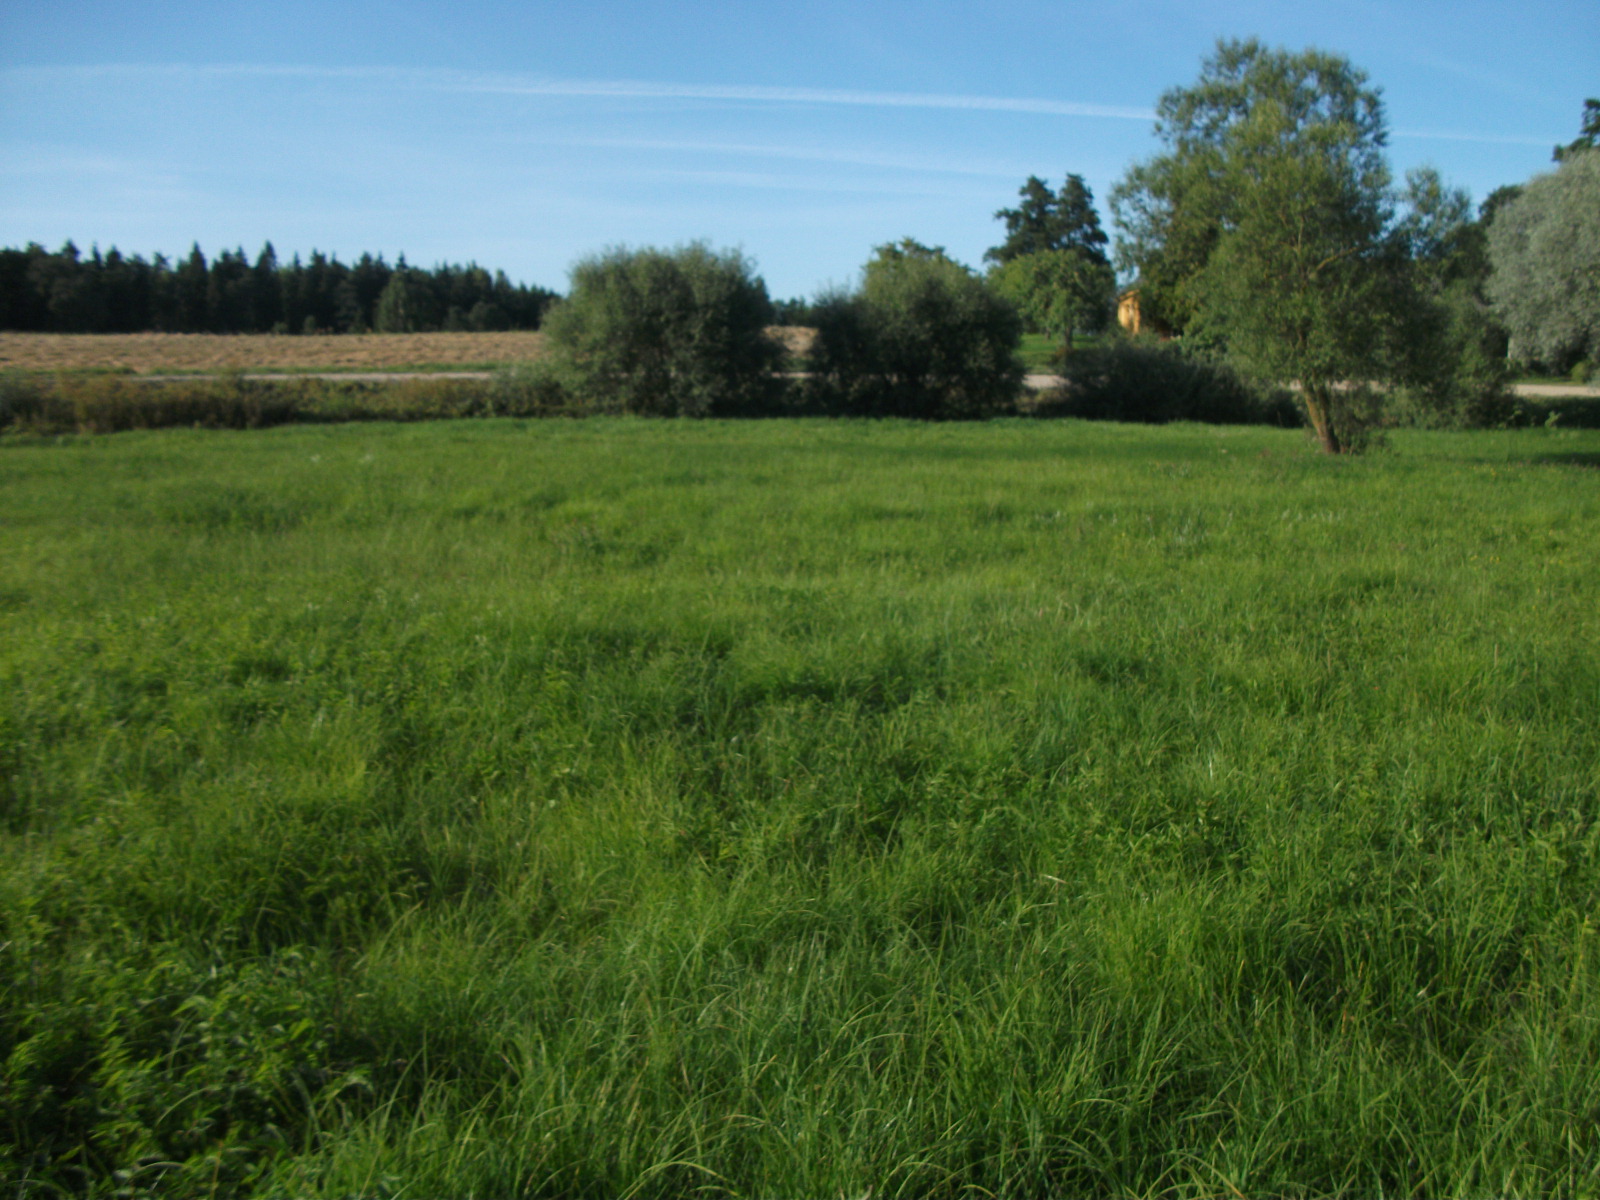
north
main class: Grassland
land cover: Grassland without tree/shrub cover
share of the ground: > 75 %
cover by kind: herbaceous plants 100 %
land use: Agriculture (excluding fallow land and kitchen gardens)
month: August
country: LV
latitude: 56.3774
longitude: 26.2200
